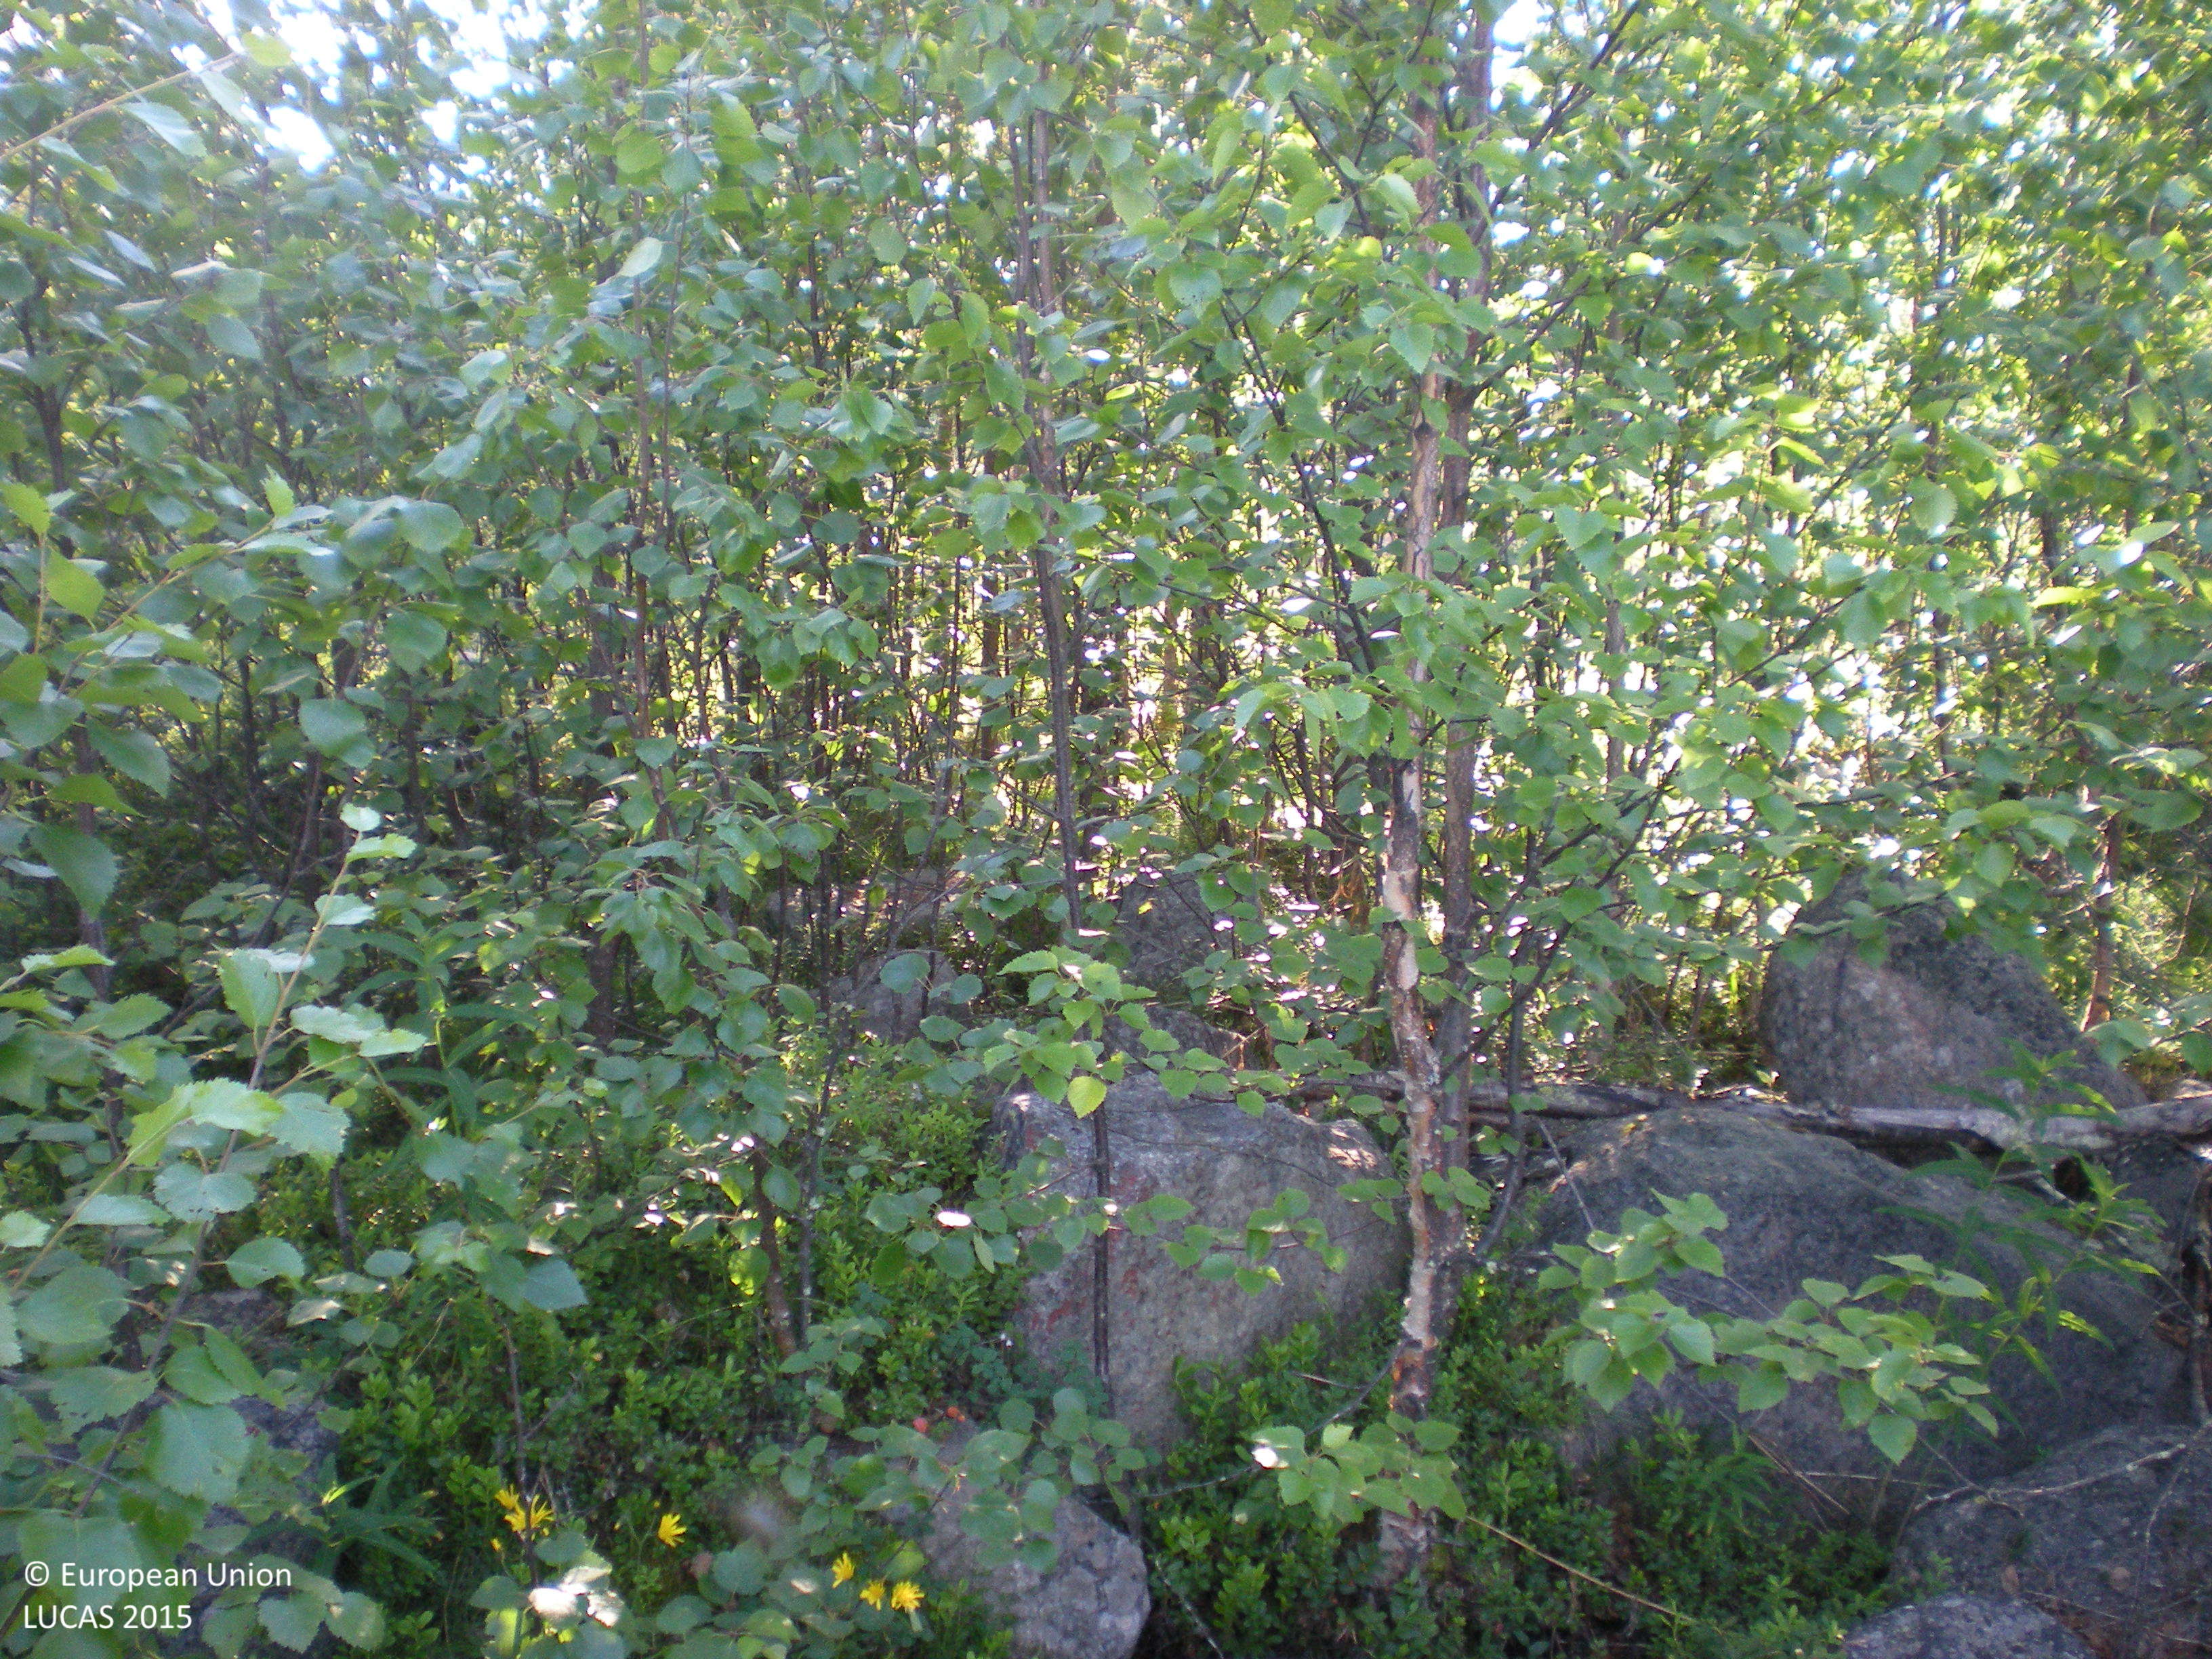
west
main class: Woodland
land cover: Pine dominated mixed woodland
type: boreal forest
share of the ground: 25 - 50 %
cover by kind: shrubs 40 %, coniferous forest trees 20 %, broadleaved forest trees 15 %, consolidated bare surface 15 %, lichens and mosses 10 %
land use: Forestry
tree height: > 5 m
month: August
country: SE
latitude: 66.2831
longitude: 18.0855
